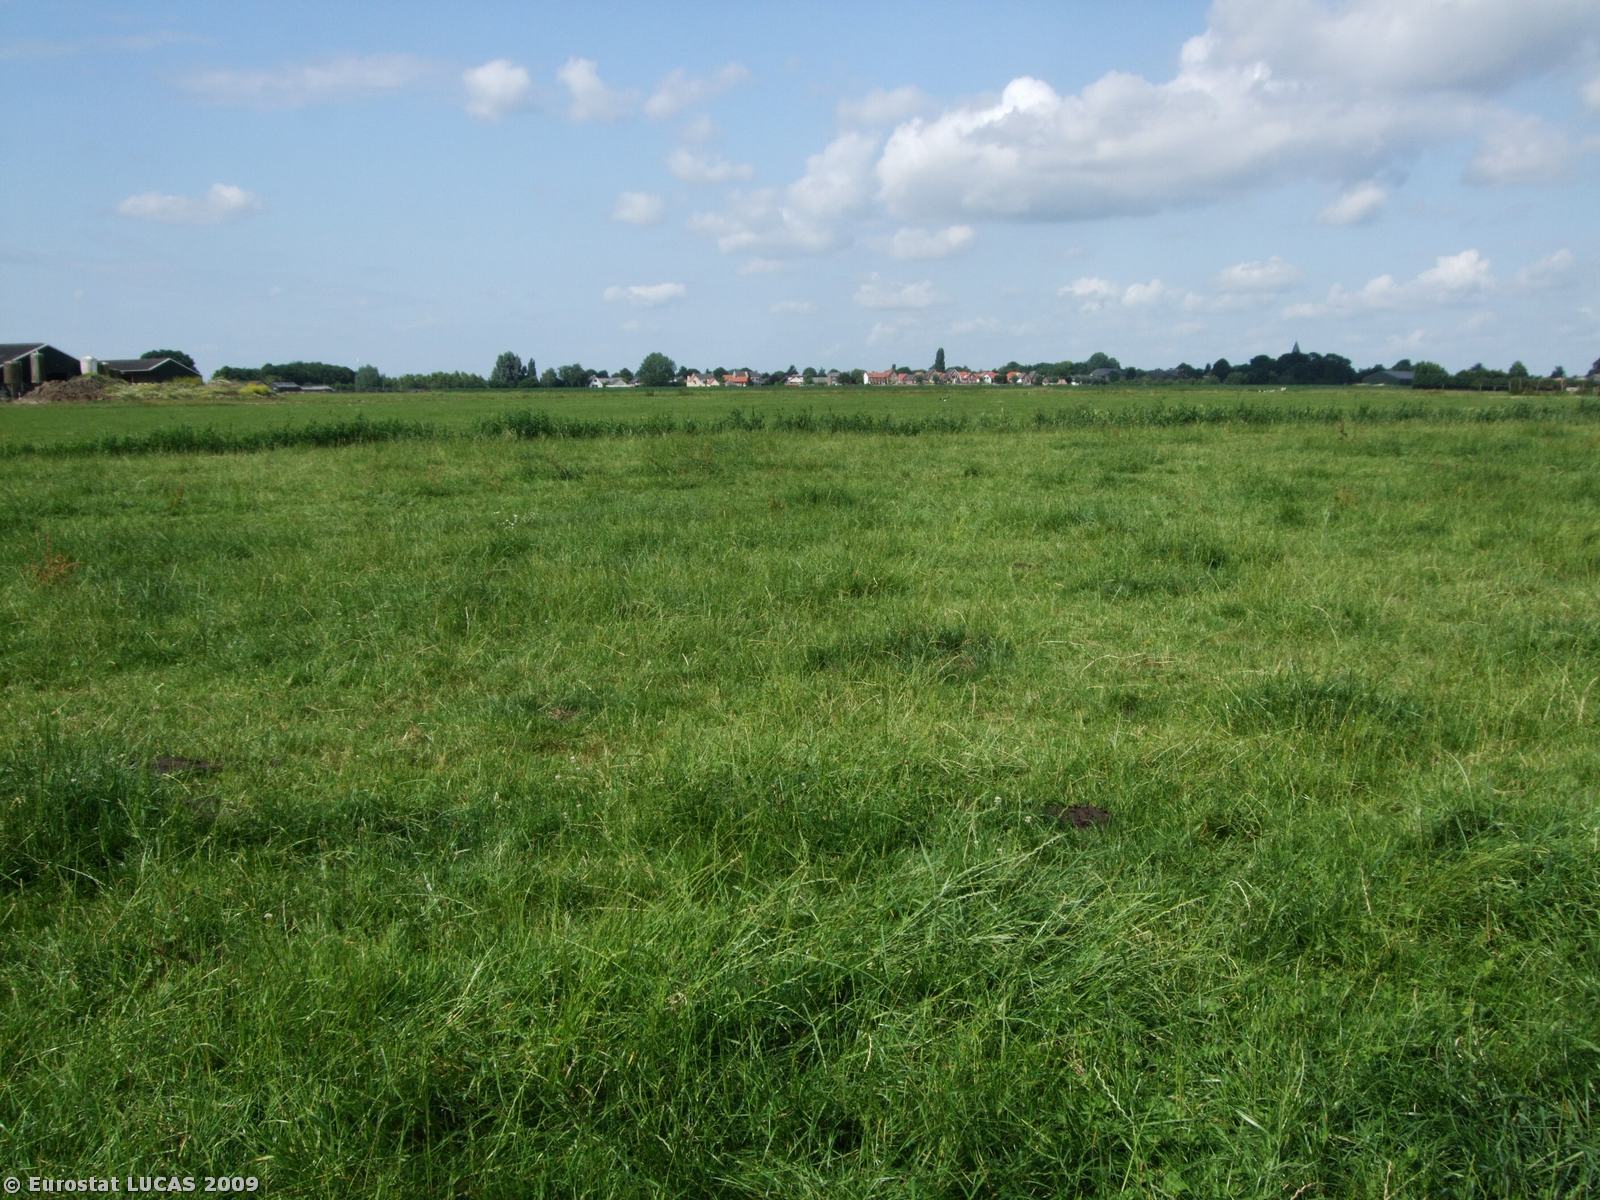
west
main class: Grassland
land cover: Grassland without tree/shrub cover
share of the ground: > 75 %
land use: Agriculture (excluding fallow land and kitchen gardens)
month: July
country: NL
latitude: 51.9435
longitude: 5.3282
